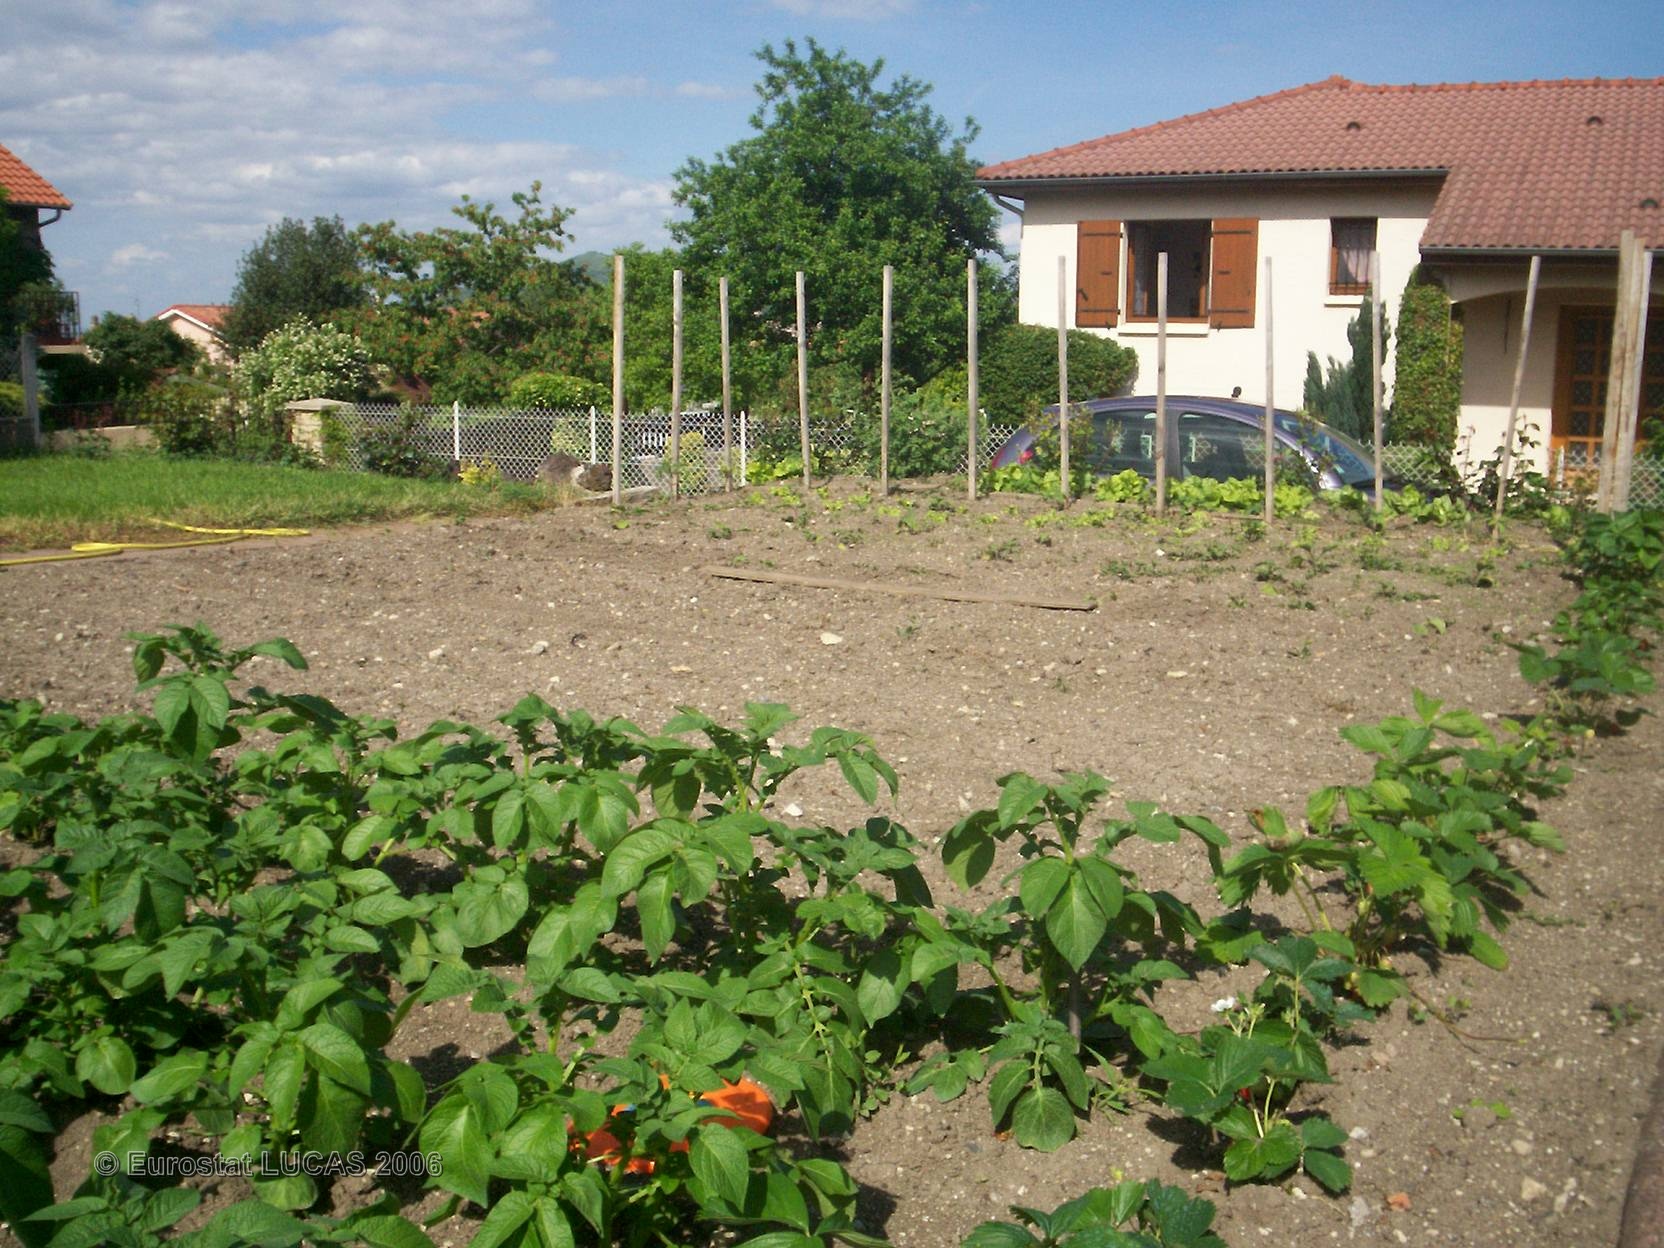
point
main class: Cropland
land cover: Other fresh vegetables
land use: Kitchen garden
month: May
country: FR
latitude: 45.7372
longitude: 3.2016
